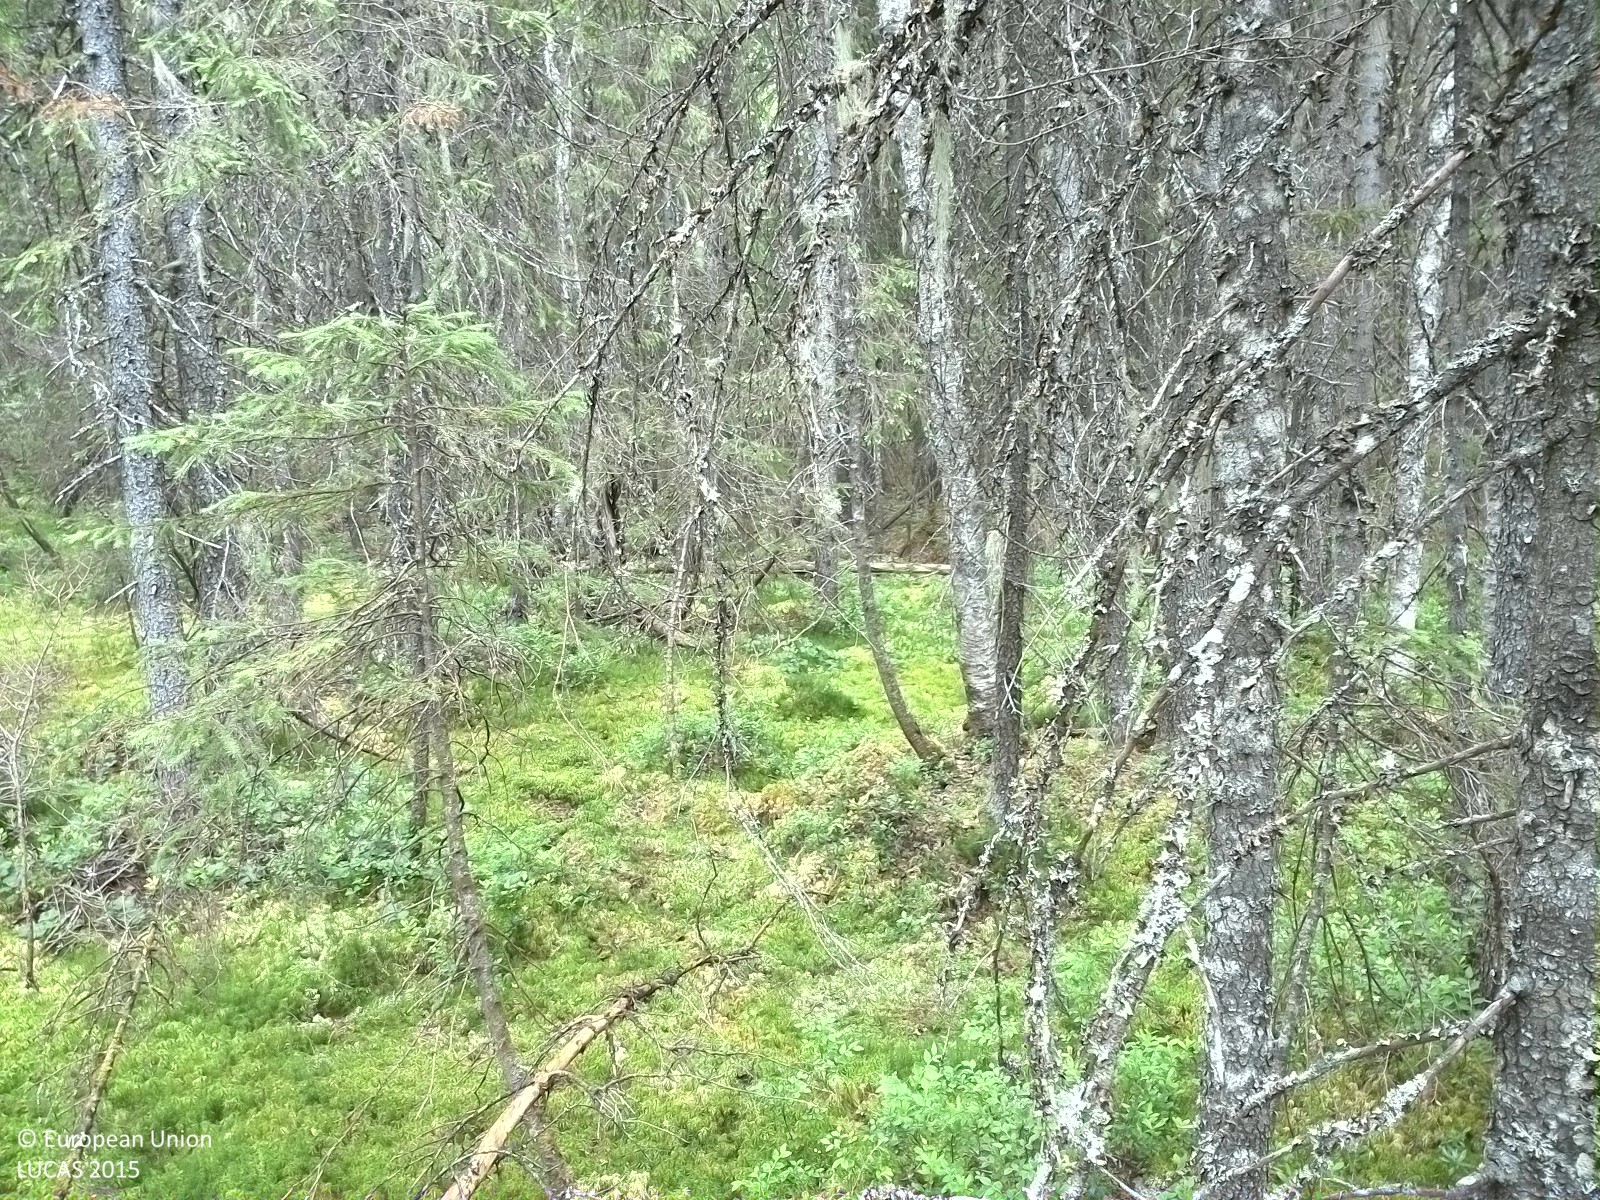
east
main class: Woodland
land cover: Spruce dominated coniferous woodland
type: boreal forest
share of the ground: 25 - 50 %
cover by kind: coniferous forest trees 45 %, lichens and mosses 30 %, shrubs 20 %, broadleaved forest trees 5 %
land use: Forestry
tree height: > 5 m
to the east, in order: Spruce dominated coniferous woodland
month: July
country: SE
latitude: 62.1084
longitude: 16.9373
